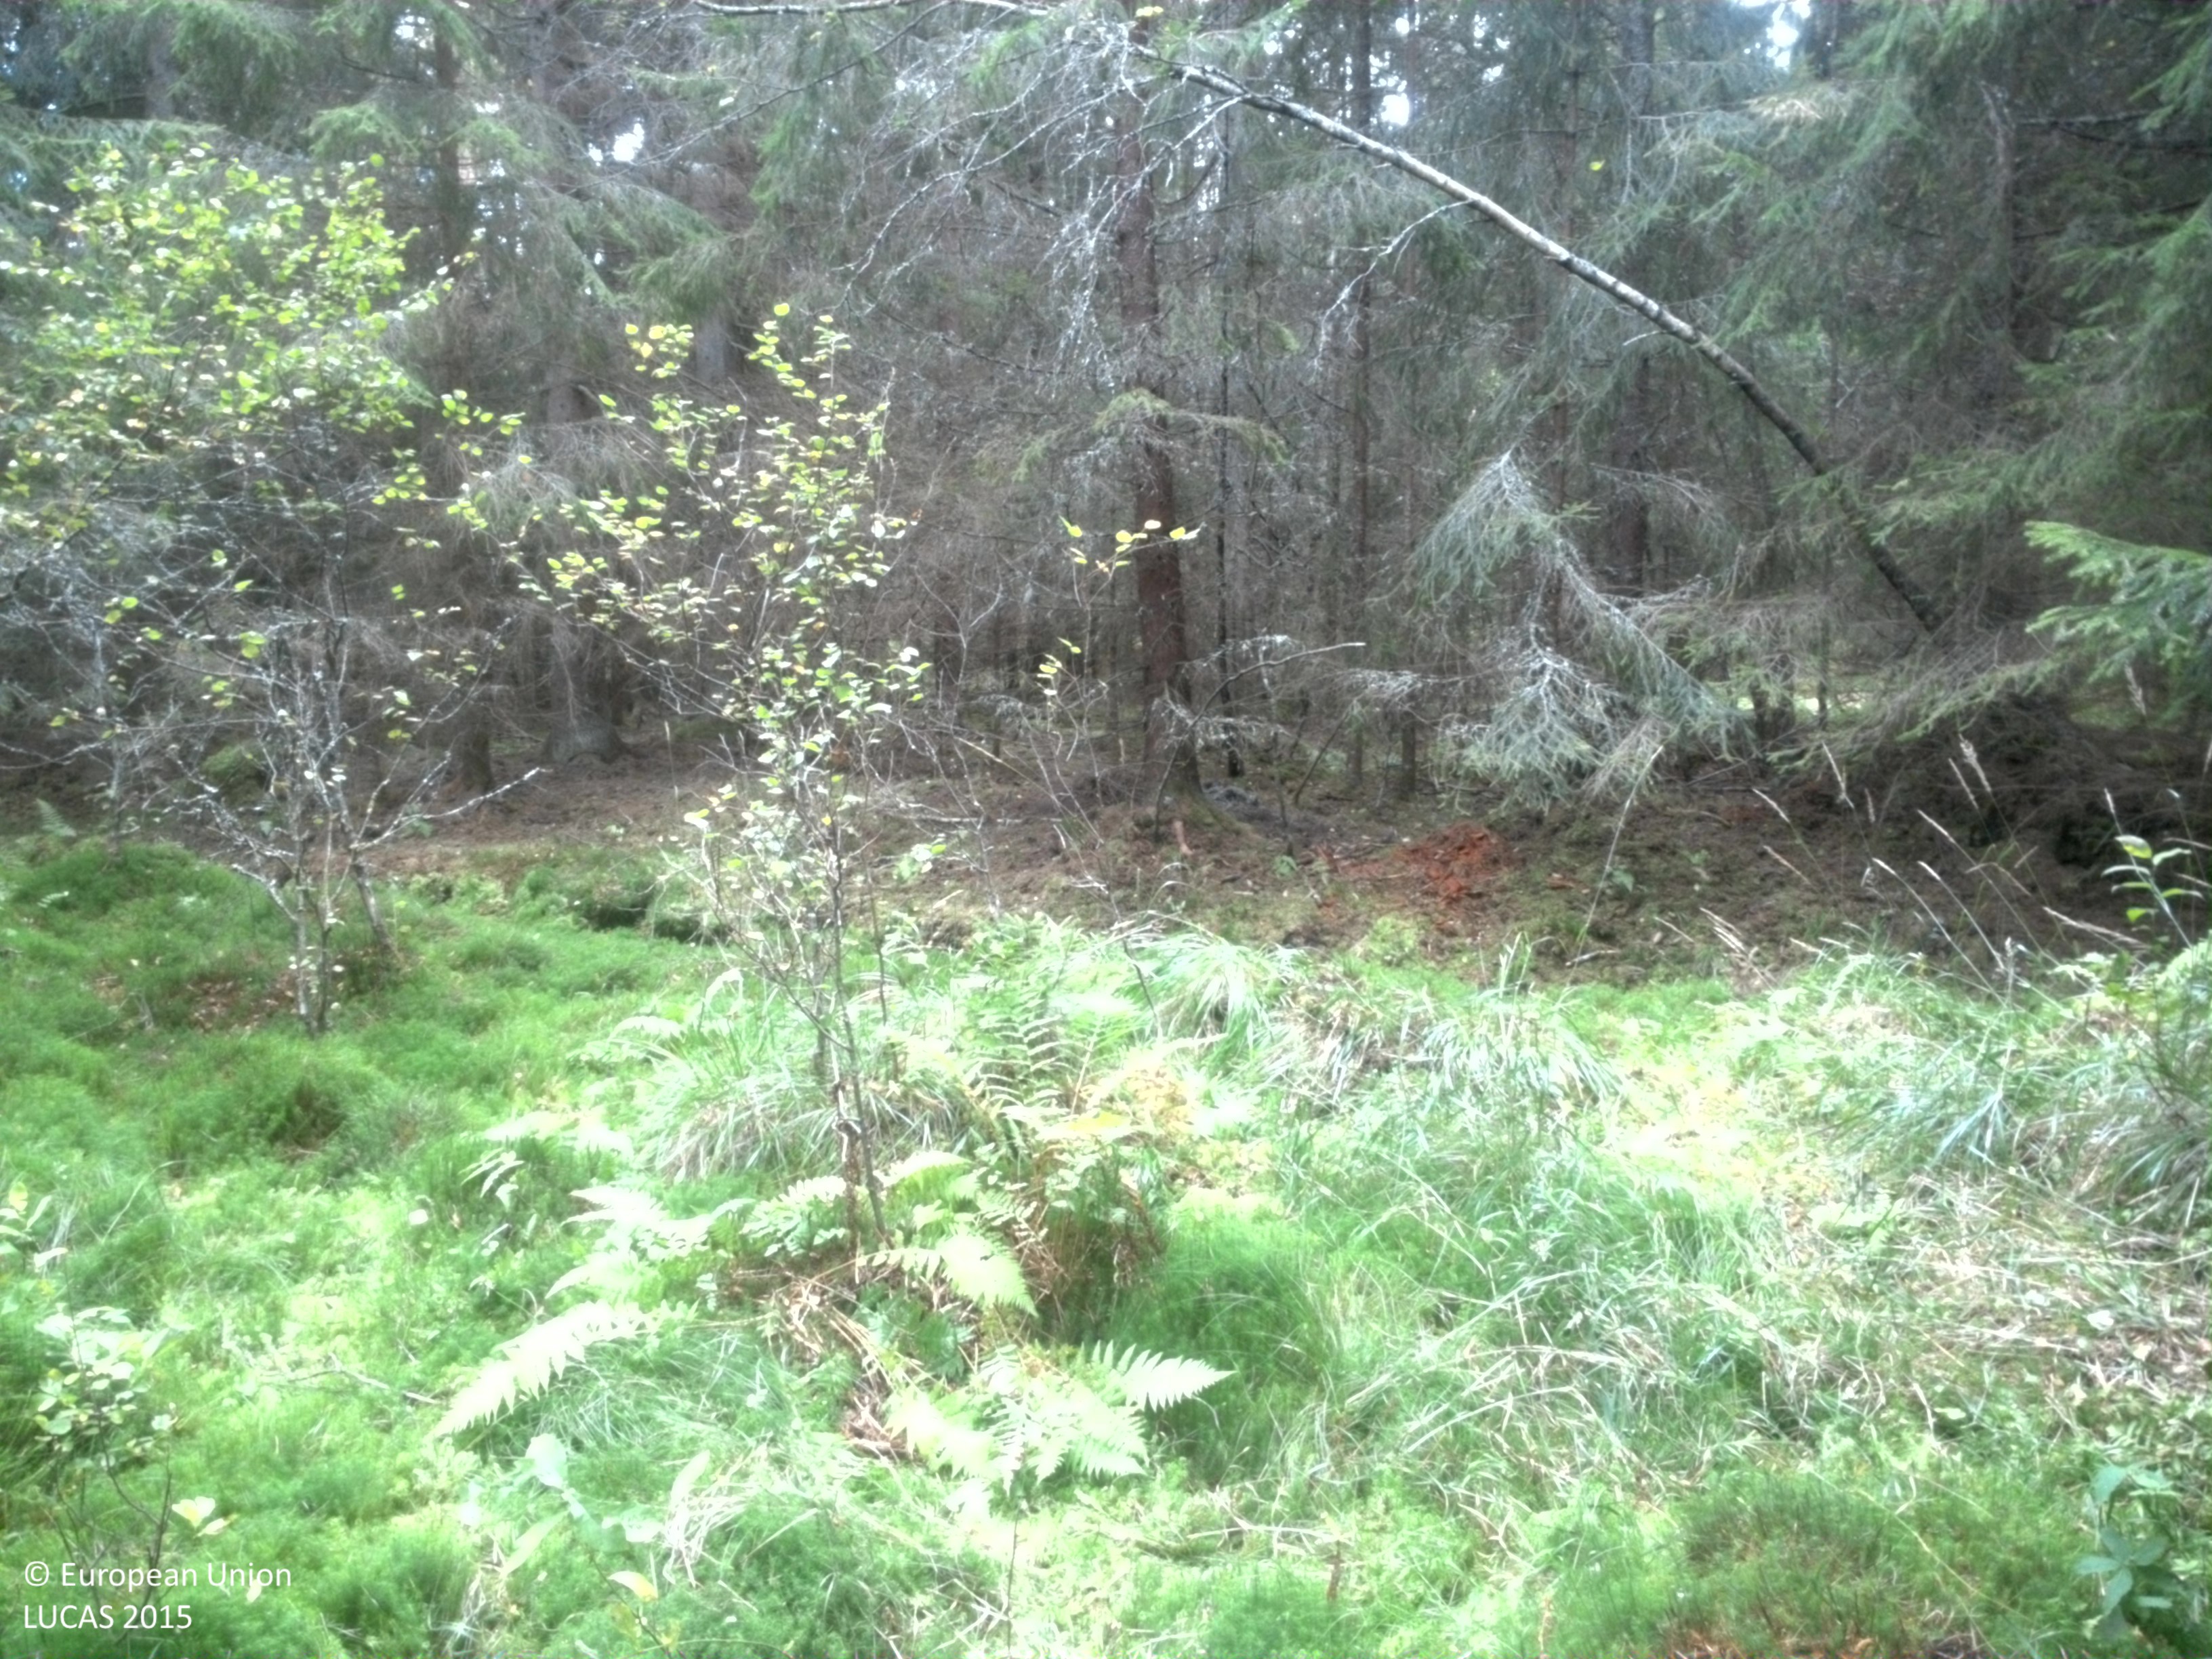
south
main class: Woodland
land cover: Spruce dominated coniferous woodland
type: boreal forest
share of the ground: 50 - 75 %
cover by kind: coniferous forest trees 60 %, lichens and mosses 20 %, broadleaved forest trees 10 %, shrubs 10 %
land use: Forestry
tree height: > 5 m
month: September
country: SE
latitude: 59.5240
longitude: 15.7008
